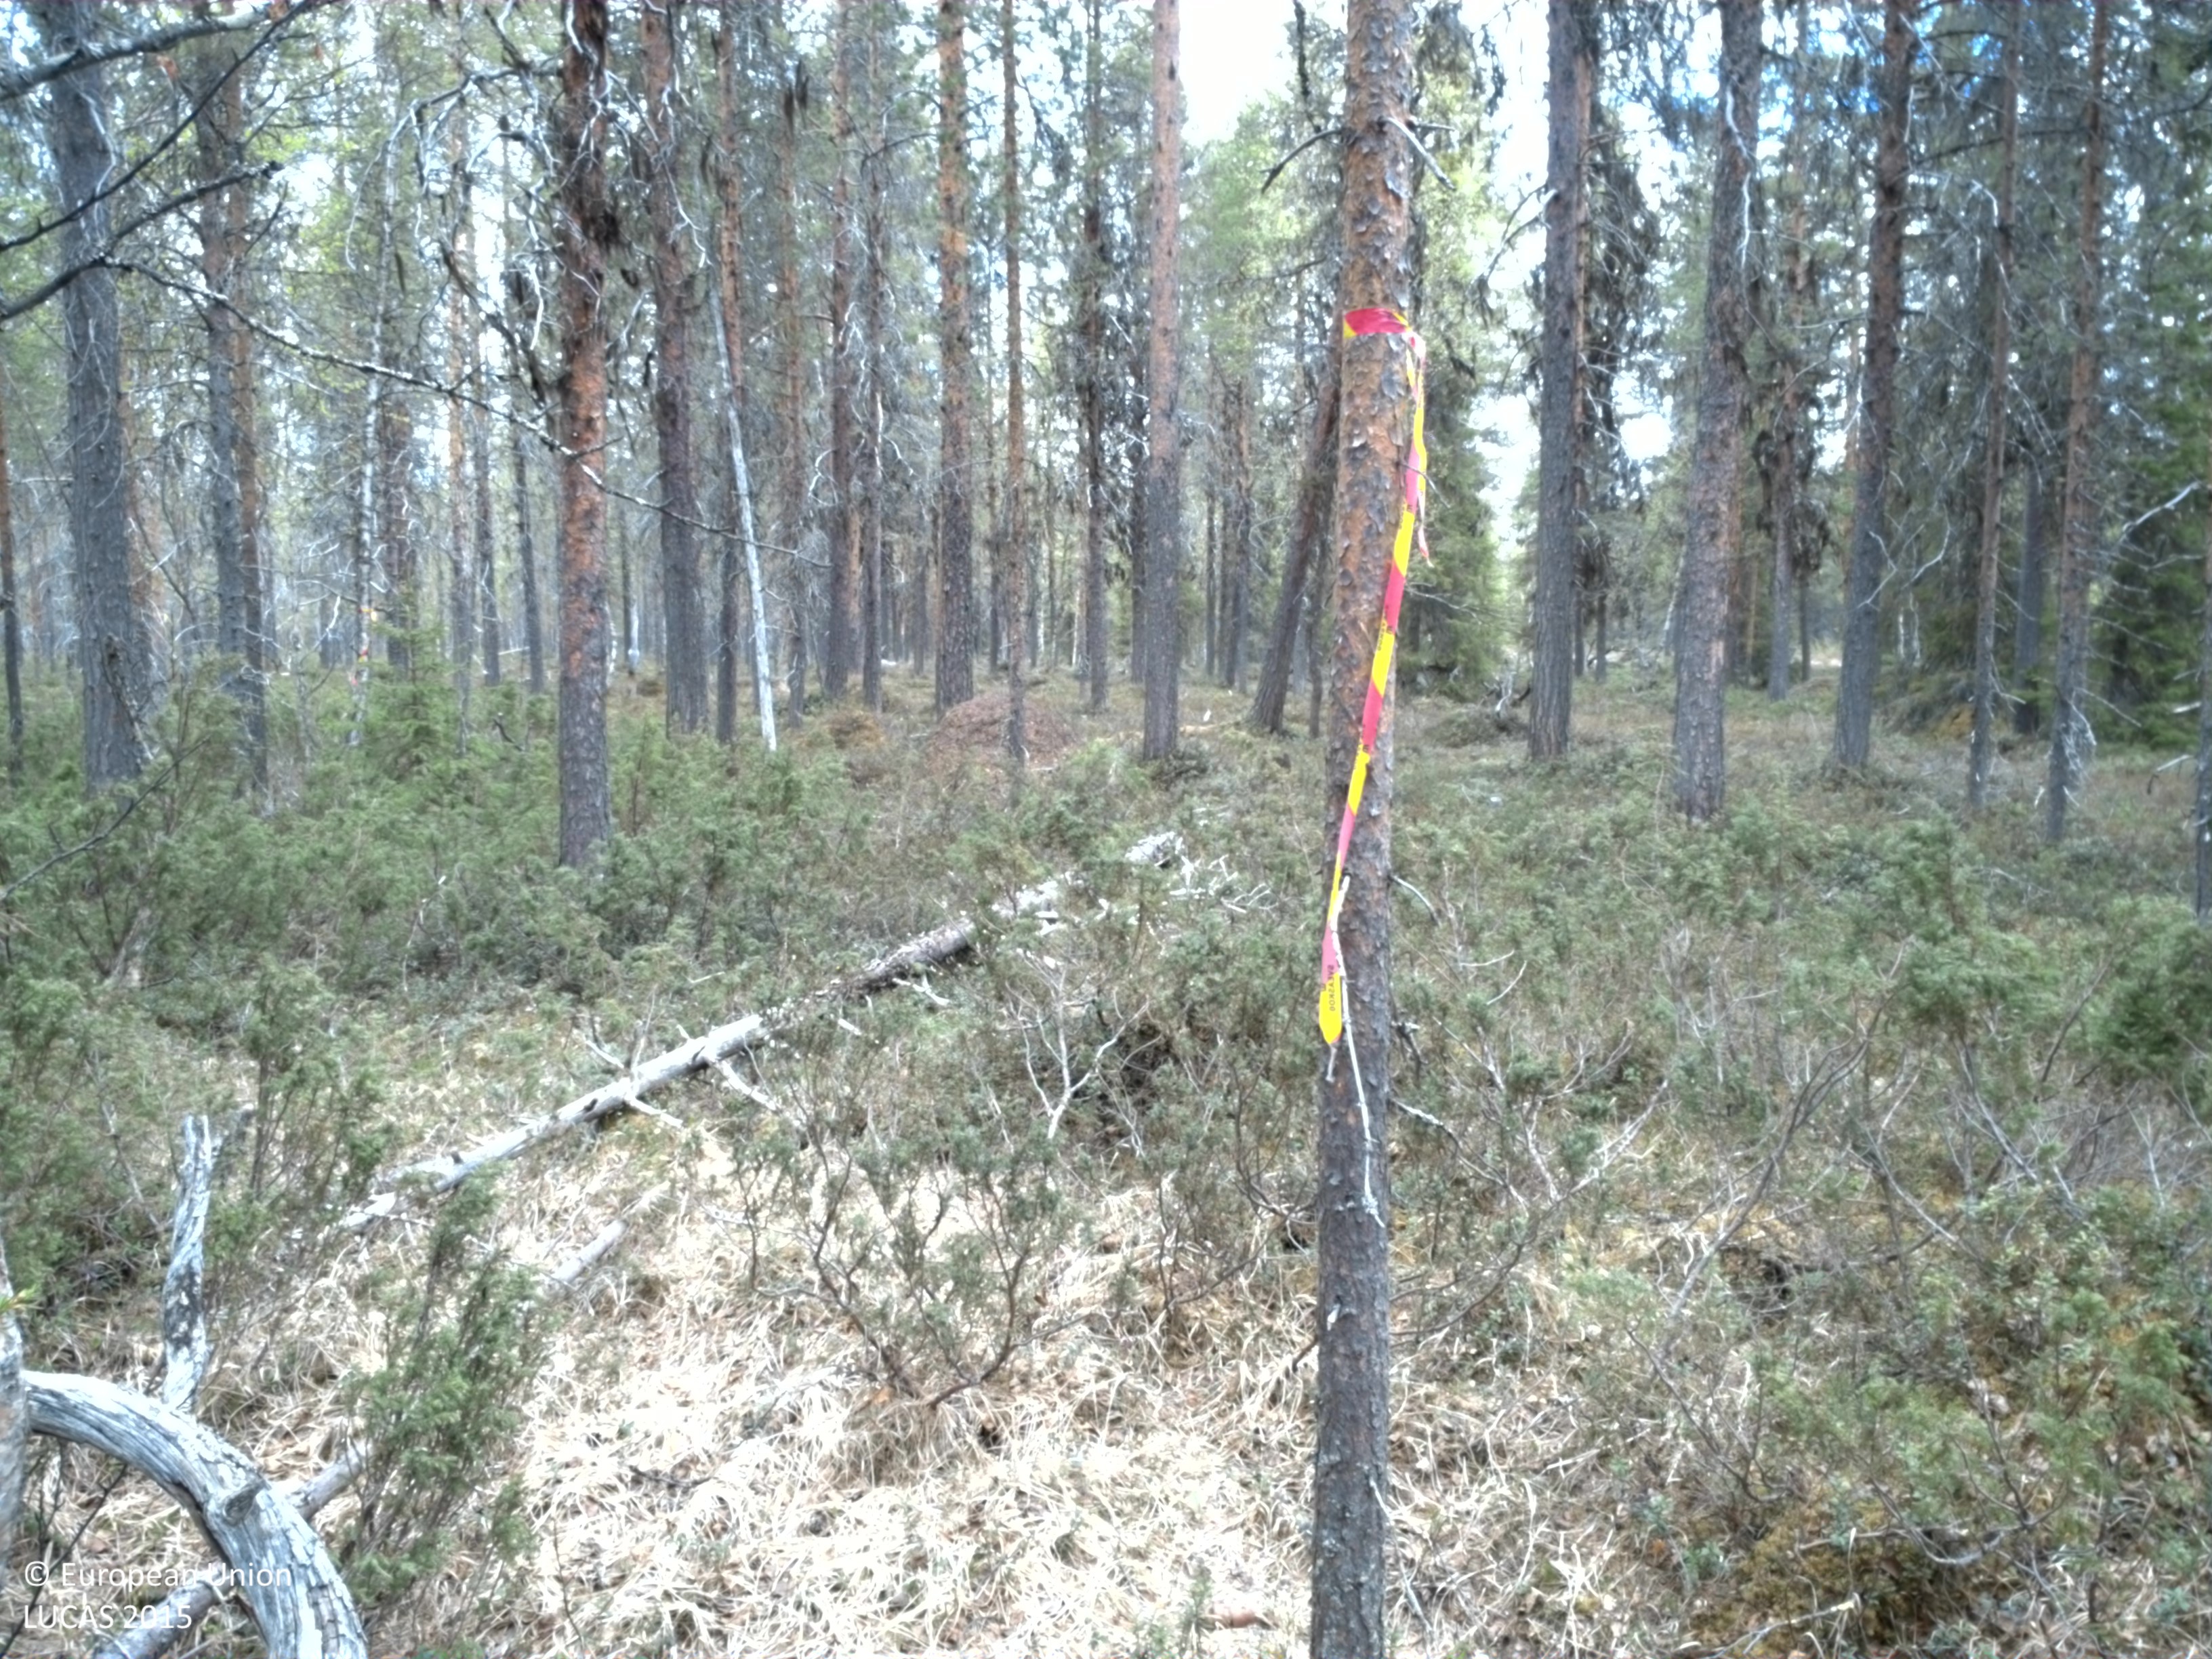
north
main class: Woodland
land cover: Pine dominated coniferous woodland
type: boreal forest
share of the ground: 50 - 75 %
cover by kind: coniferous forest trees 50 %, shrubs 35 %, herbaceous plants 10 %, broadleaved forest trees 5 %
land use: Forestry
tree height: > 5 m
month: June
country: SE
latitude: 66.0868
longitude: 18.7322
